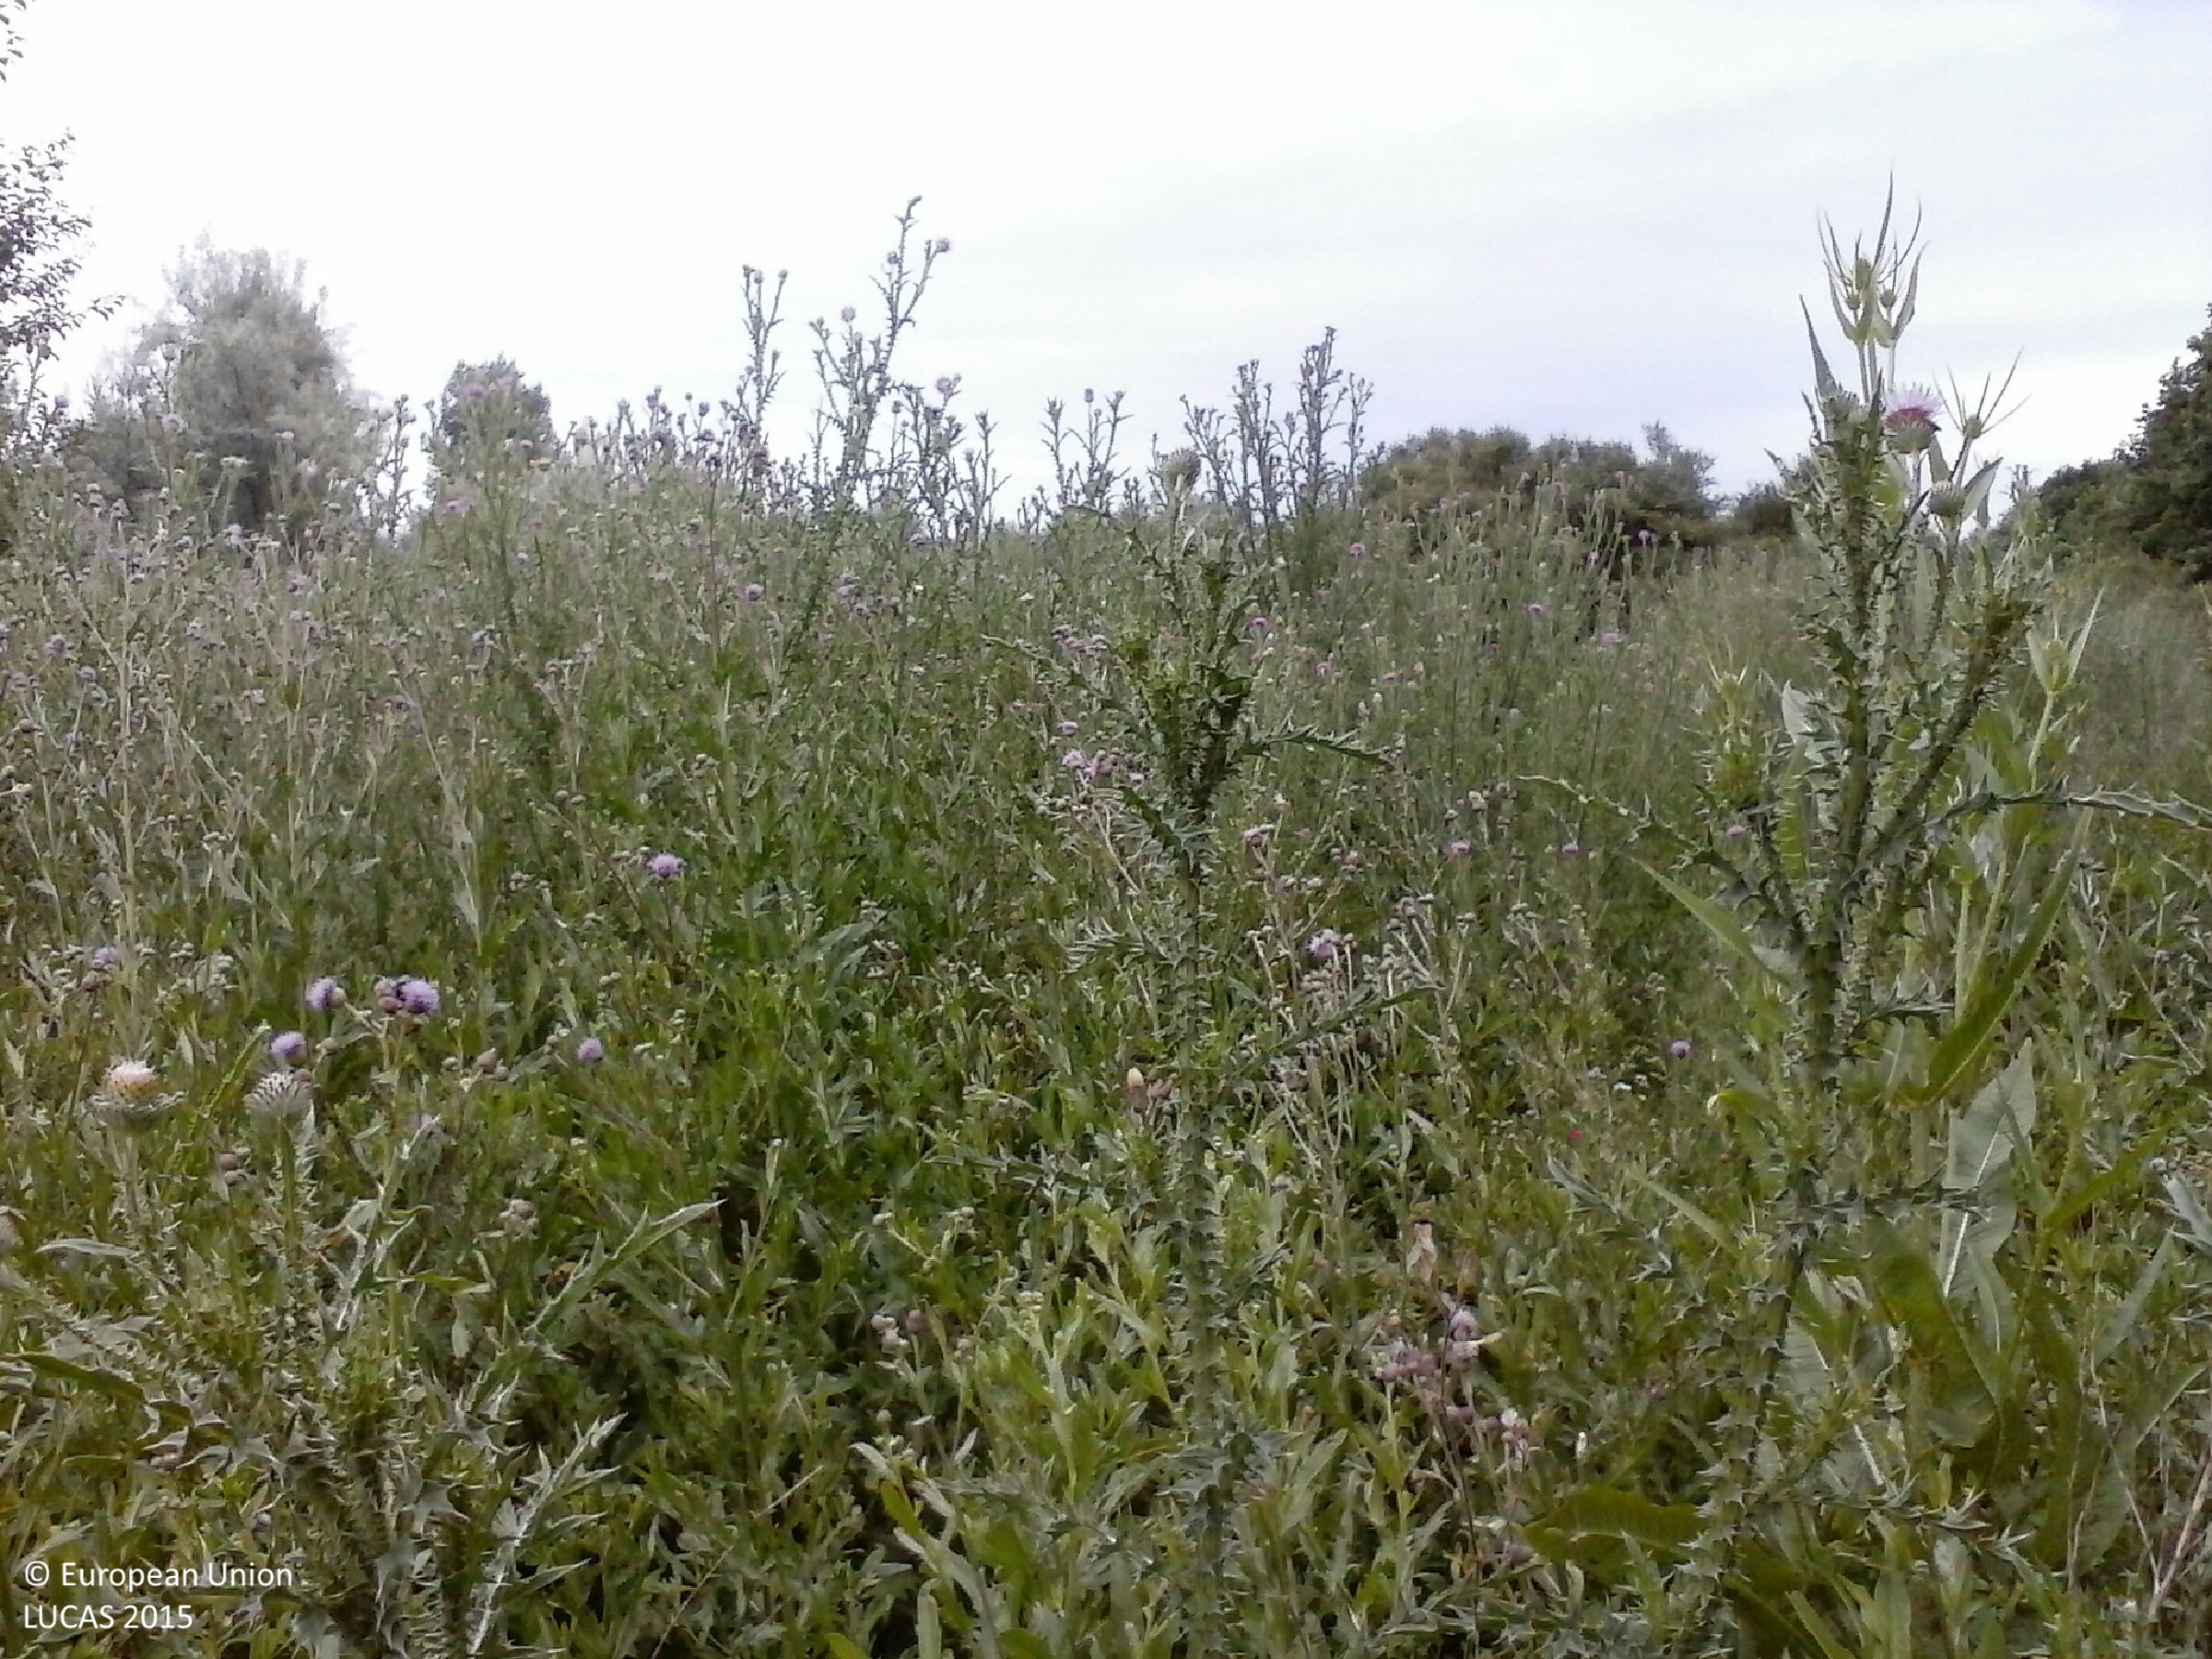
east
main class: Grassland
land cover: Spontaneously vegetated surfaces
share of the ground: > 75 %
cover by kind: herbaceous plants 100 %
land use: Water supply and treatment
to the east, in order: Spontaneously vegetated surfaces; Inland fresh running water; Spontaneously vegetated surfaces
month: June
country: HU
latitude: 46.1848
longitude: 20.2445
